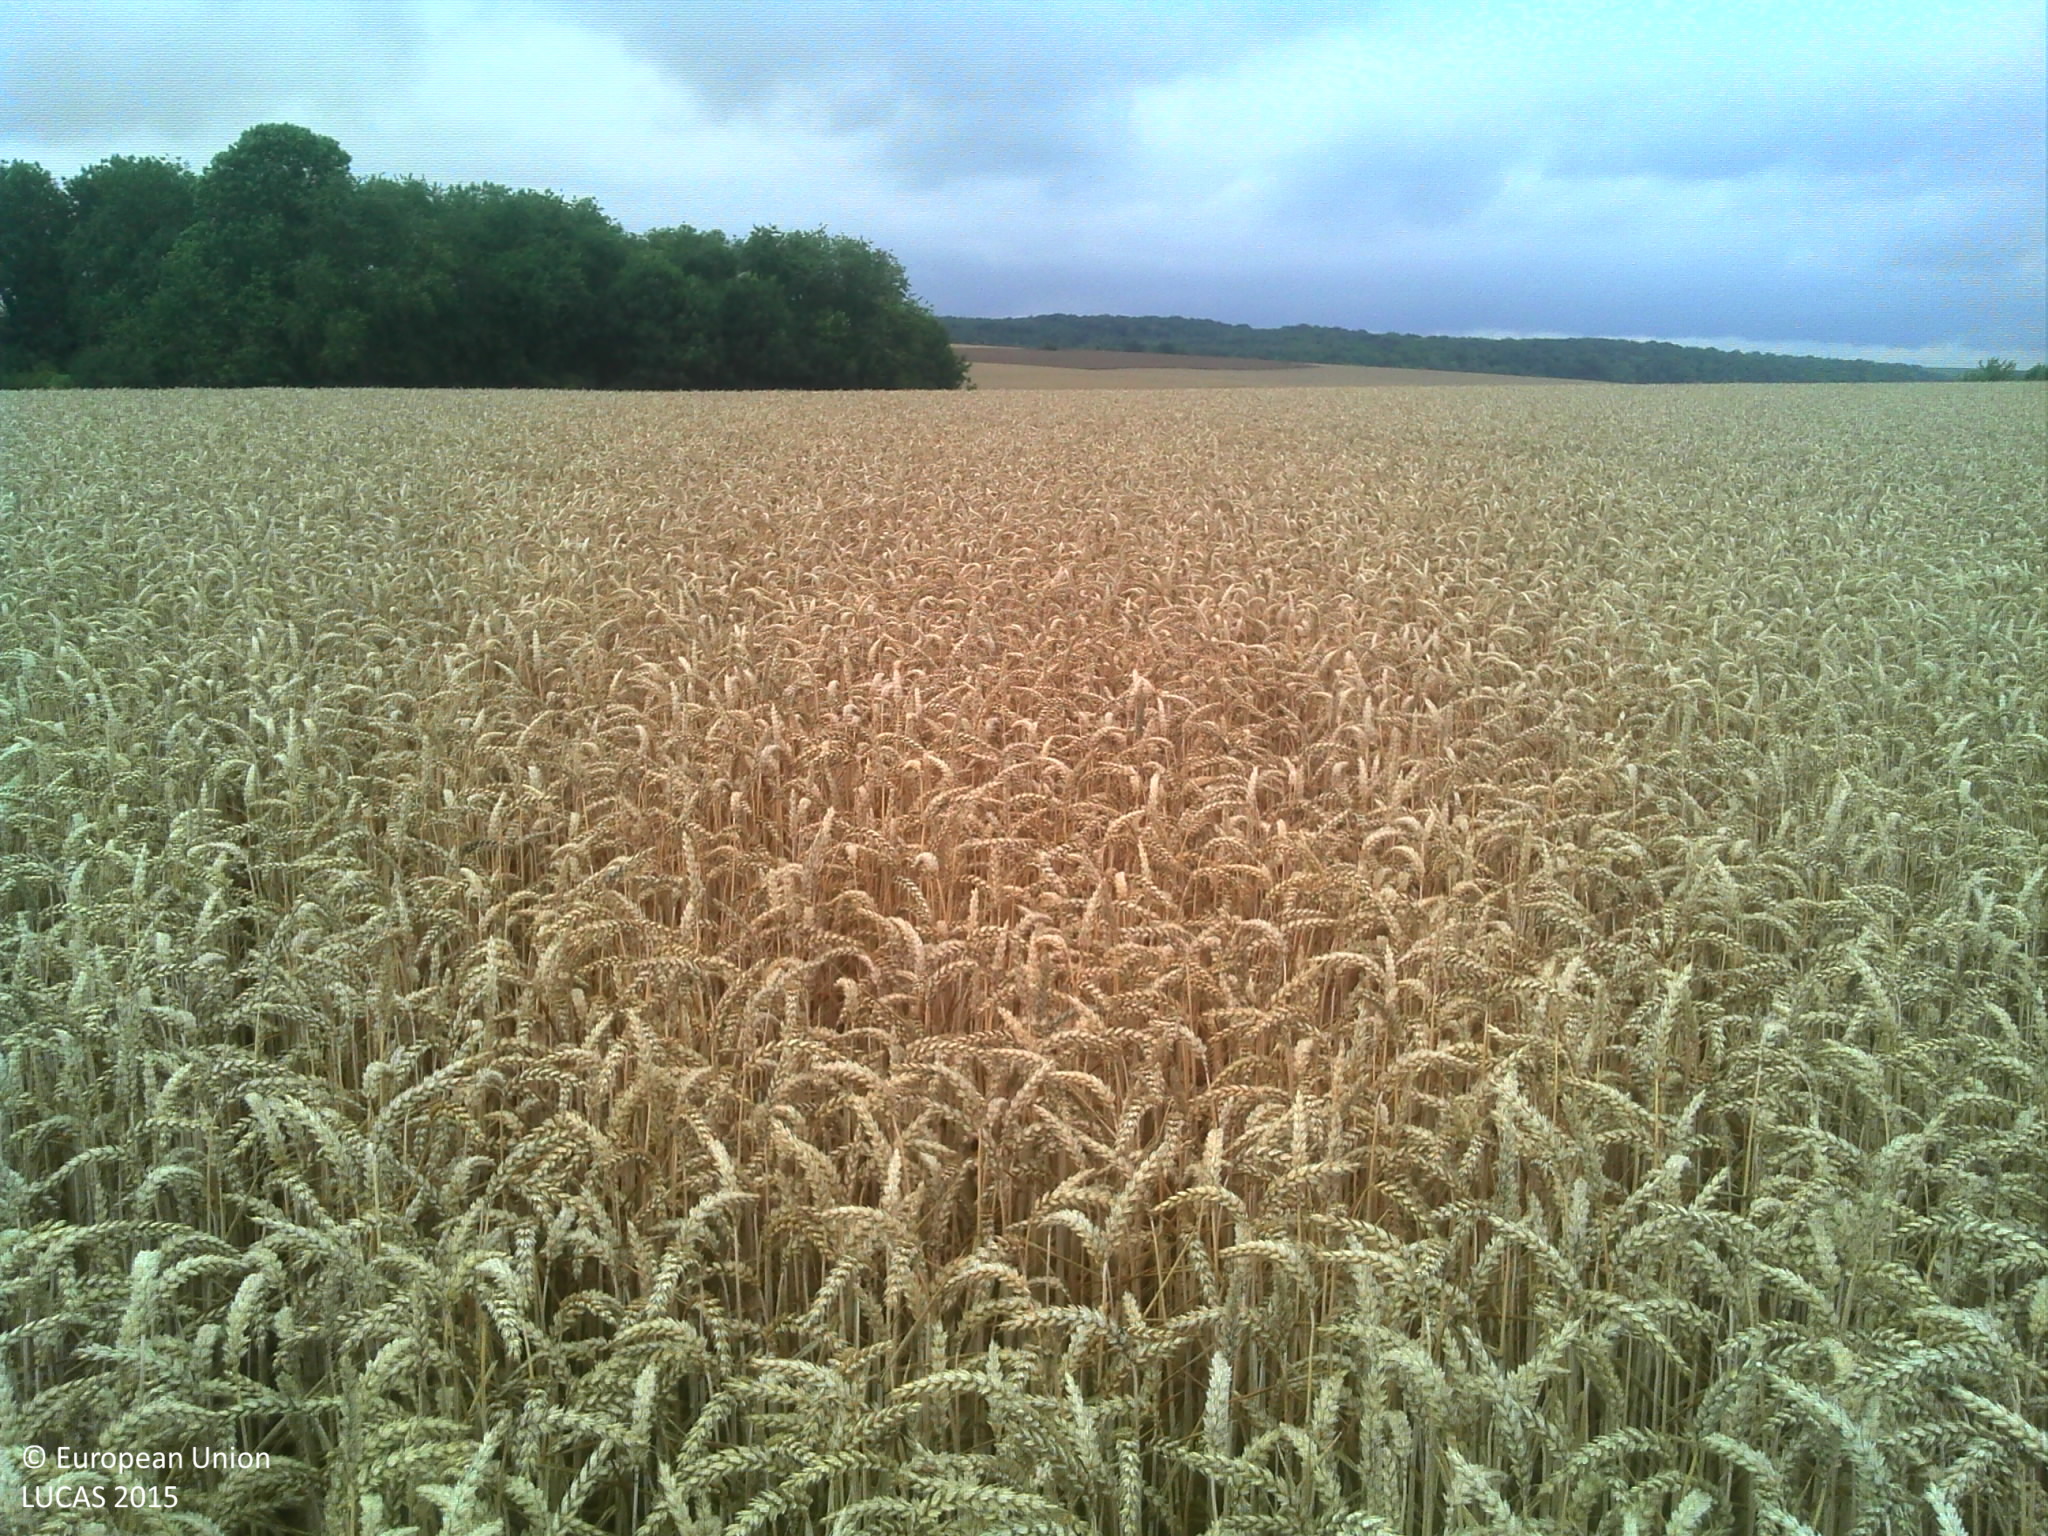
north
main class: Cropland
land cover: Common wheat
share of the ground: > 75 %
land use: Agriculture (excluding fallow land and kitchen gardens)
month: July
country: FR
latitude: 49.7010
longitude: 3.6570
